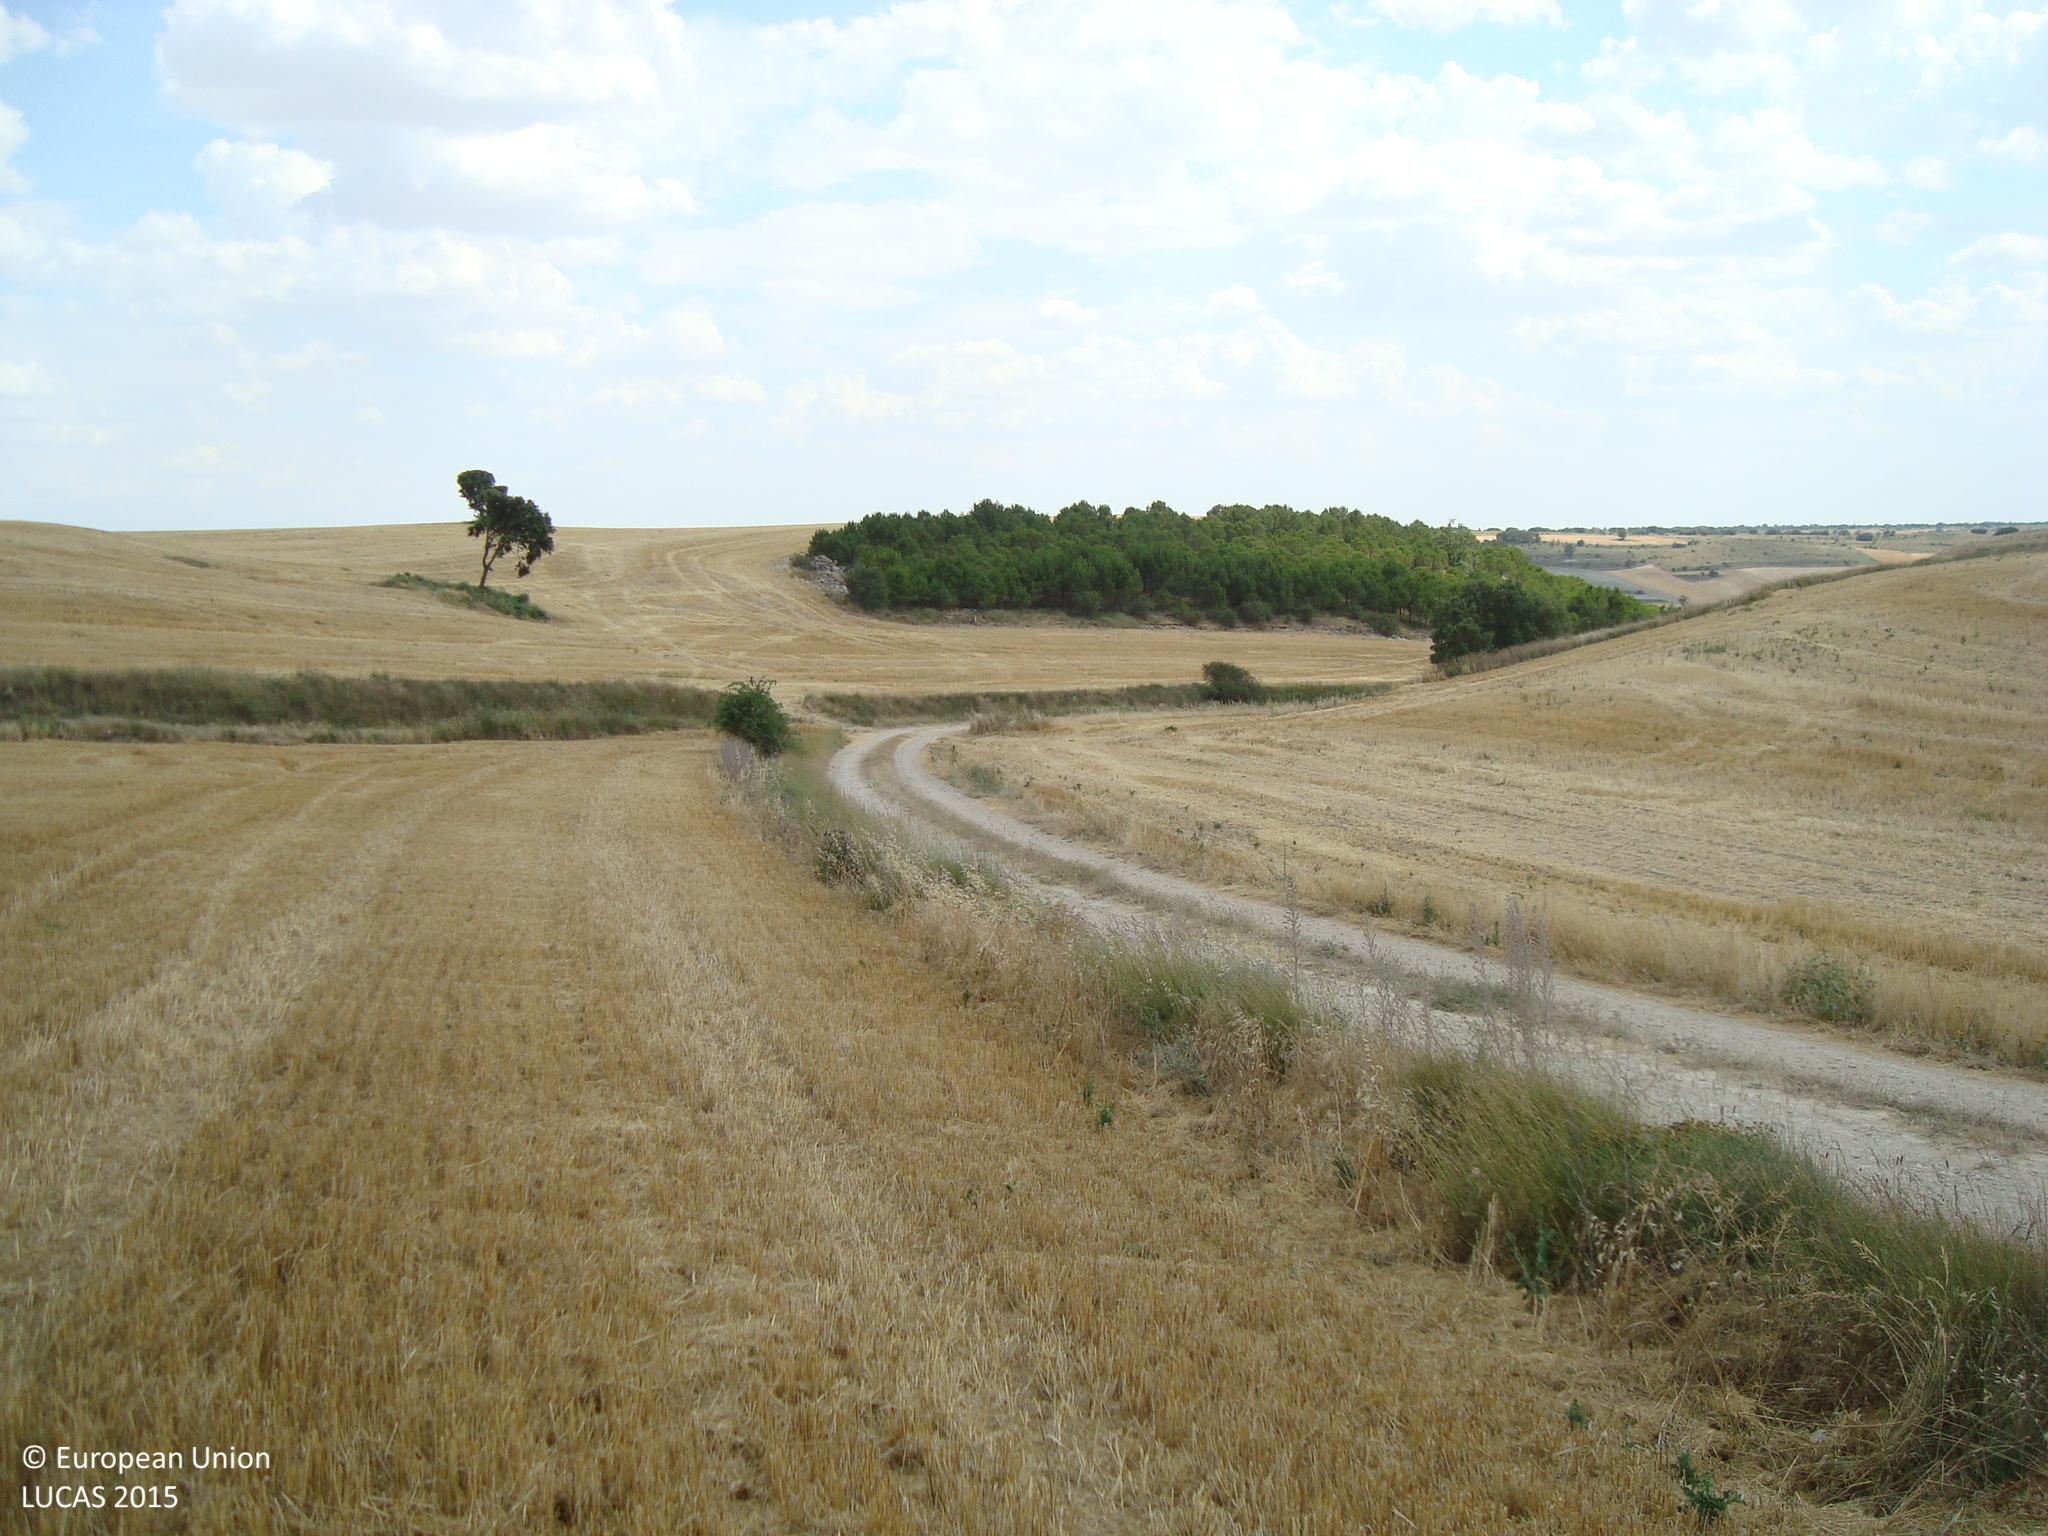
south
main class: Cropland
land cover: Barley
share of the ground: > 75 %
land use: Agriculture (excluding fallow land and kitchen gardens)
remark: Harvested field
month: July
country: ES
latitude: 41.9559
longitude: -4.0932
